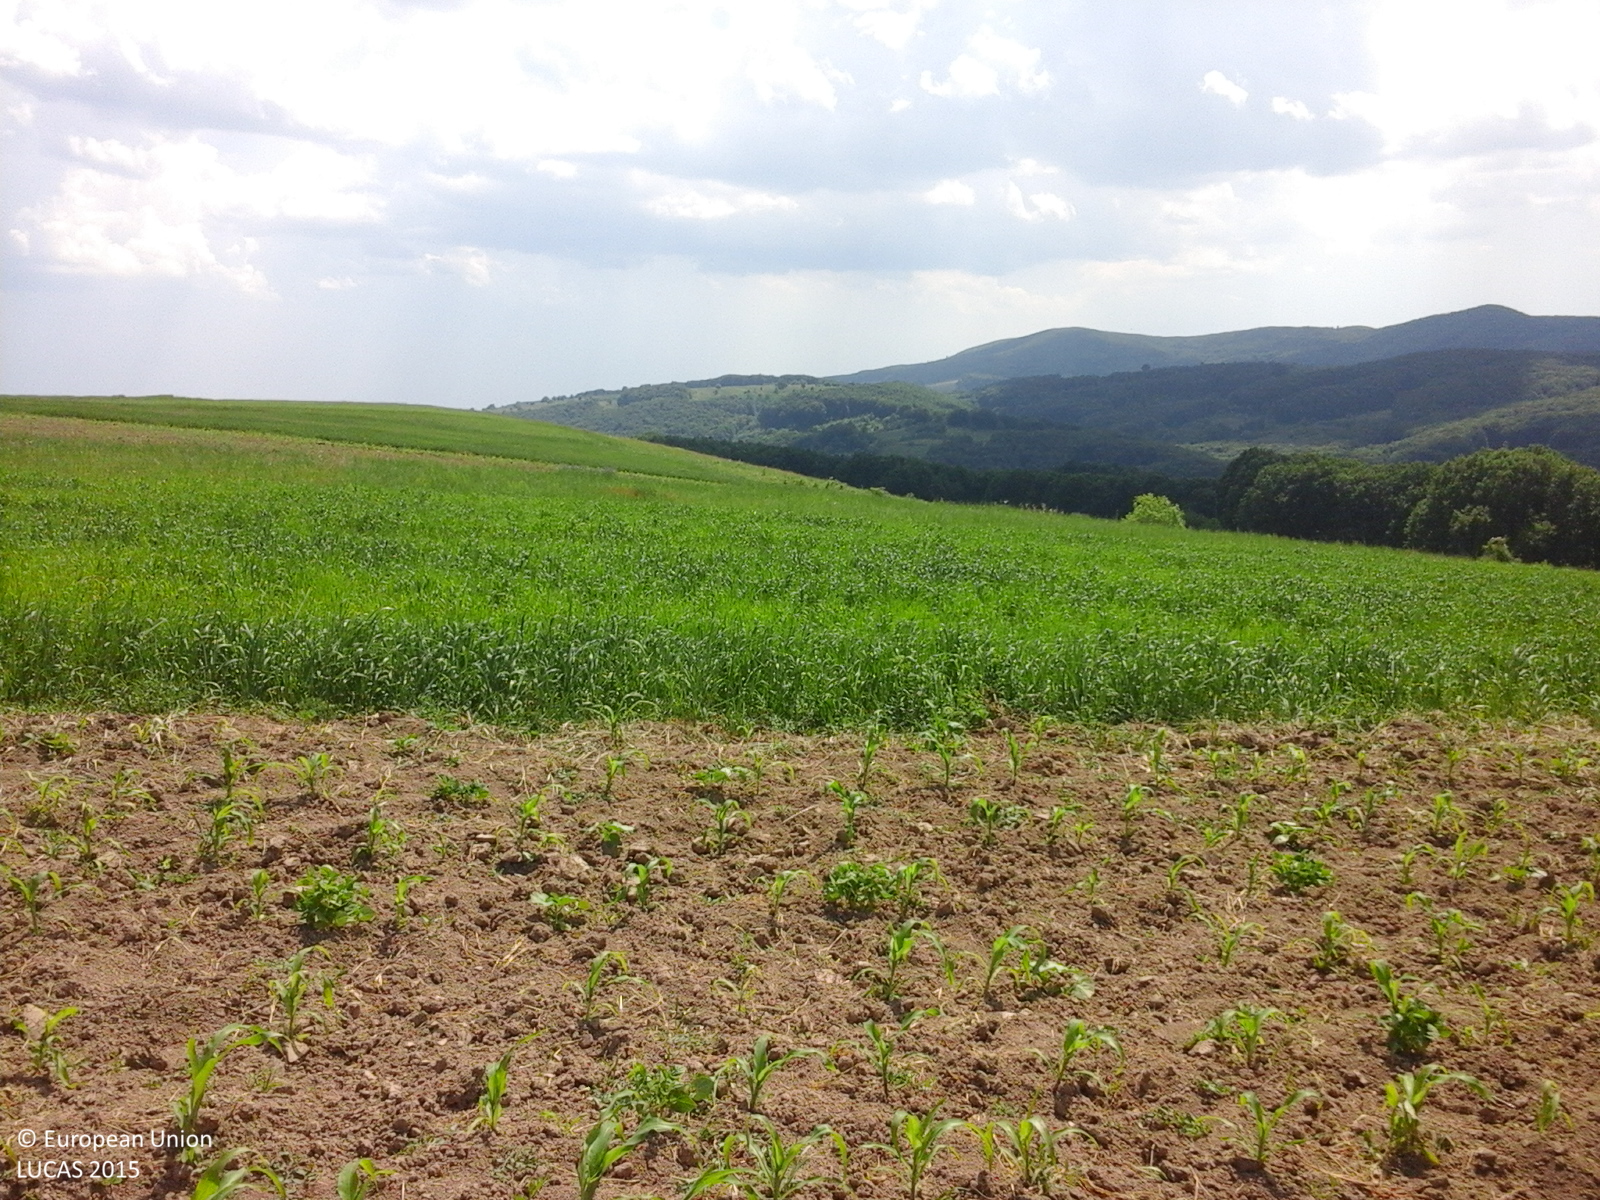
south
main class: Cropland
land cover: Maize
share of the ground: 10 - 25 %
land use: Agriculture (excluding fallow land and kitchen gardens)
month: June
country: RO
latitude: 46.3768
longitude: 26.8757
